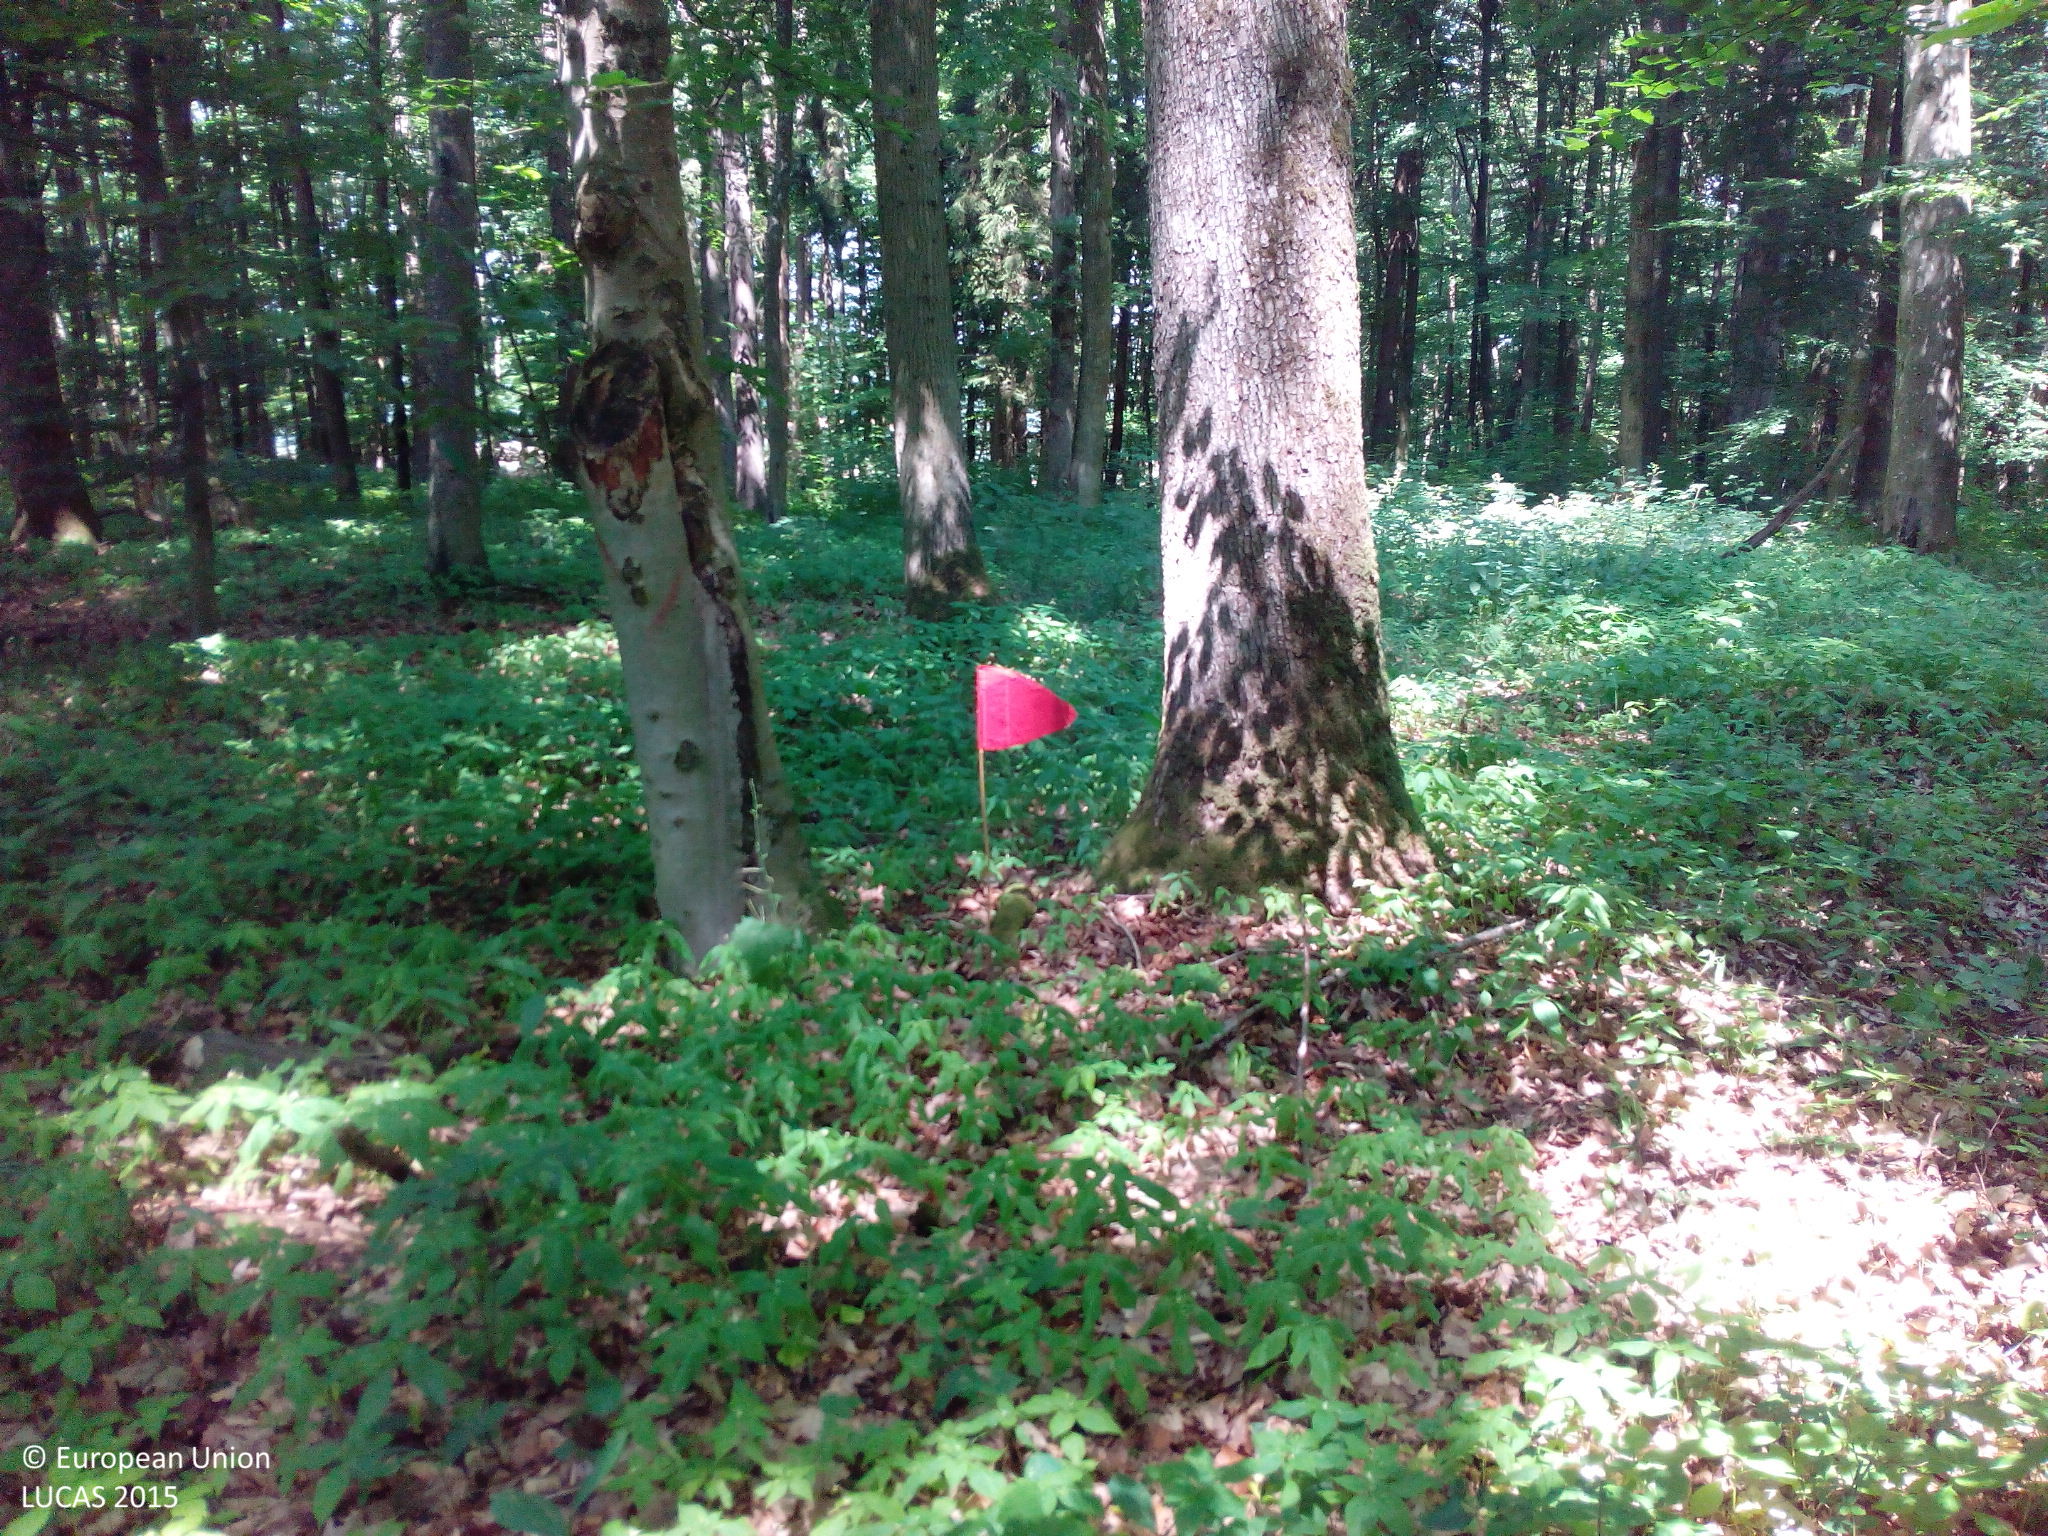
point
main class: Woodland
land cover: Broadleaved woodland
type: mesophytic deciduous forest
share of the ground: > 75 %
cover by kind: broadleaved forest trees 90 %, herbaceous plants 10 %
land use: Forestry
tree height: > 5 m
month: July
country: DE
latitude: 49.5368
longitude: 9.9309
